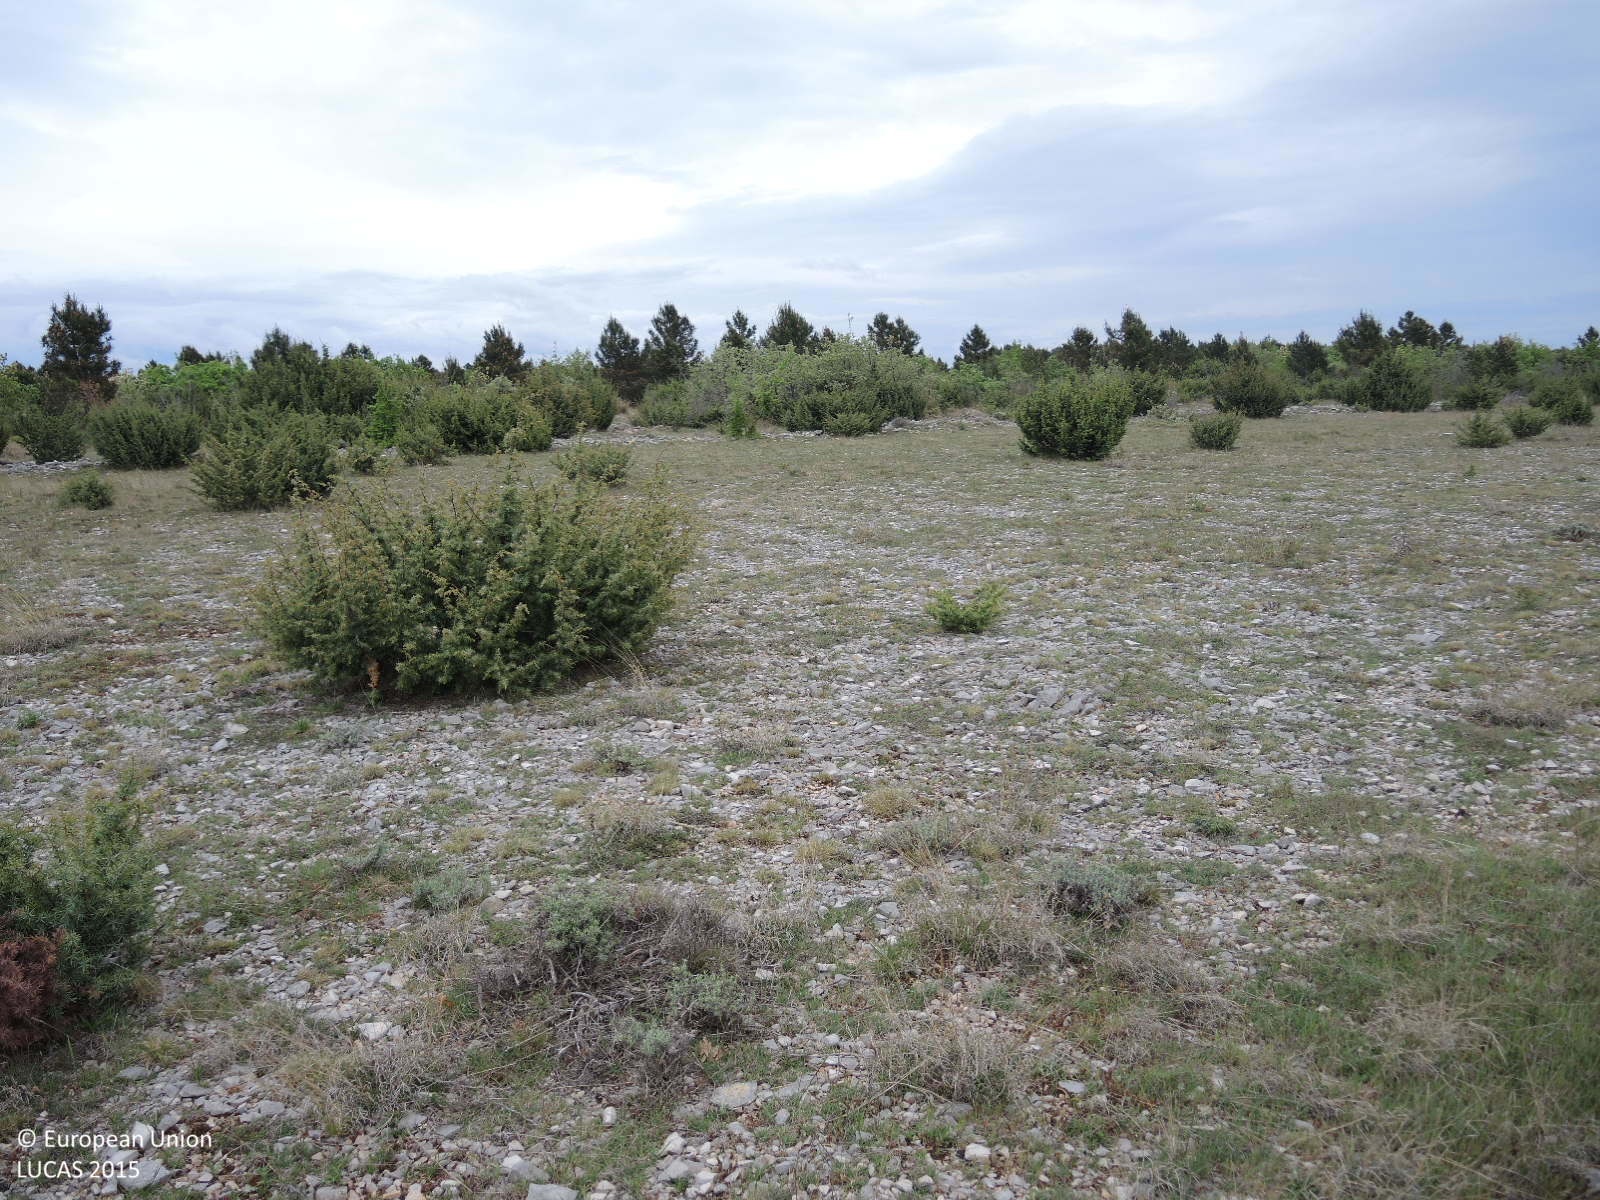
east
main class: Grassland
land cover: Grassland with sparse tree/shrub cover
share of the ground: > 75 %
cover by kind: herbaceous plants 75 %, unconsolidated bare surface 15 %, coniferous forest trees 5 %, shrubs 5 %
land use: Semi-natural and natural areas not in use
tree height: < 5 m
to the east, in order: Grassland with sparse tree/shrub cover; Shrubland with sparse tree cover; Tracks; Shrubland with sparse tree cover
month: April
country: HR
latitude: 44.0729
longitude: 15.5983
